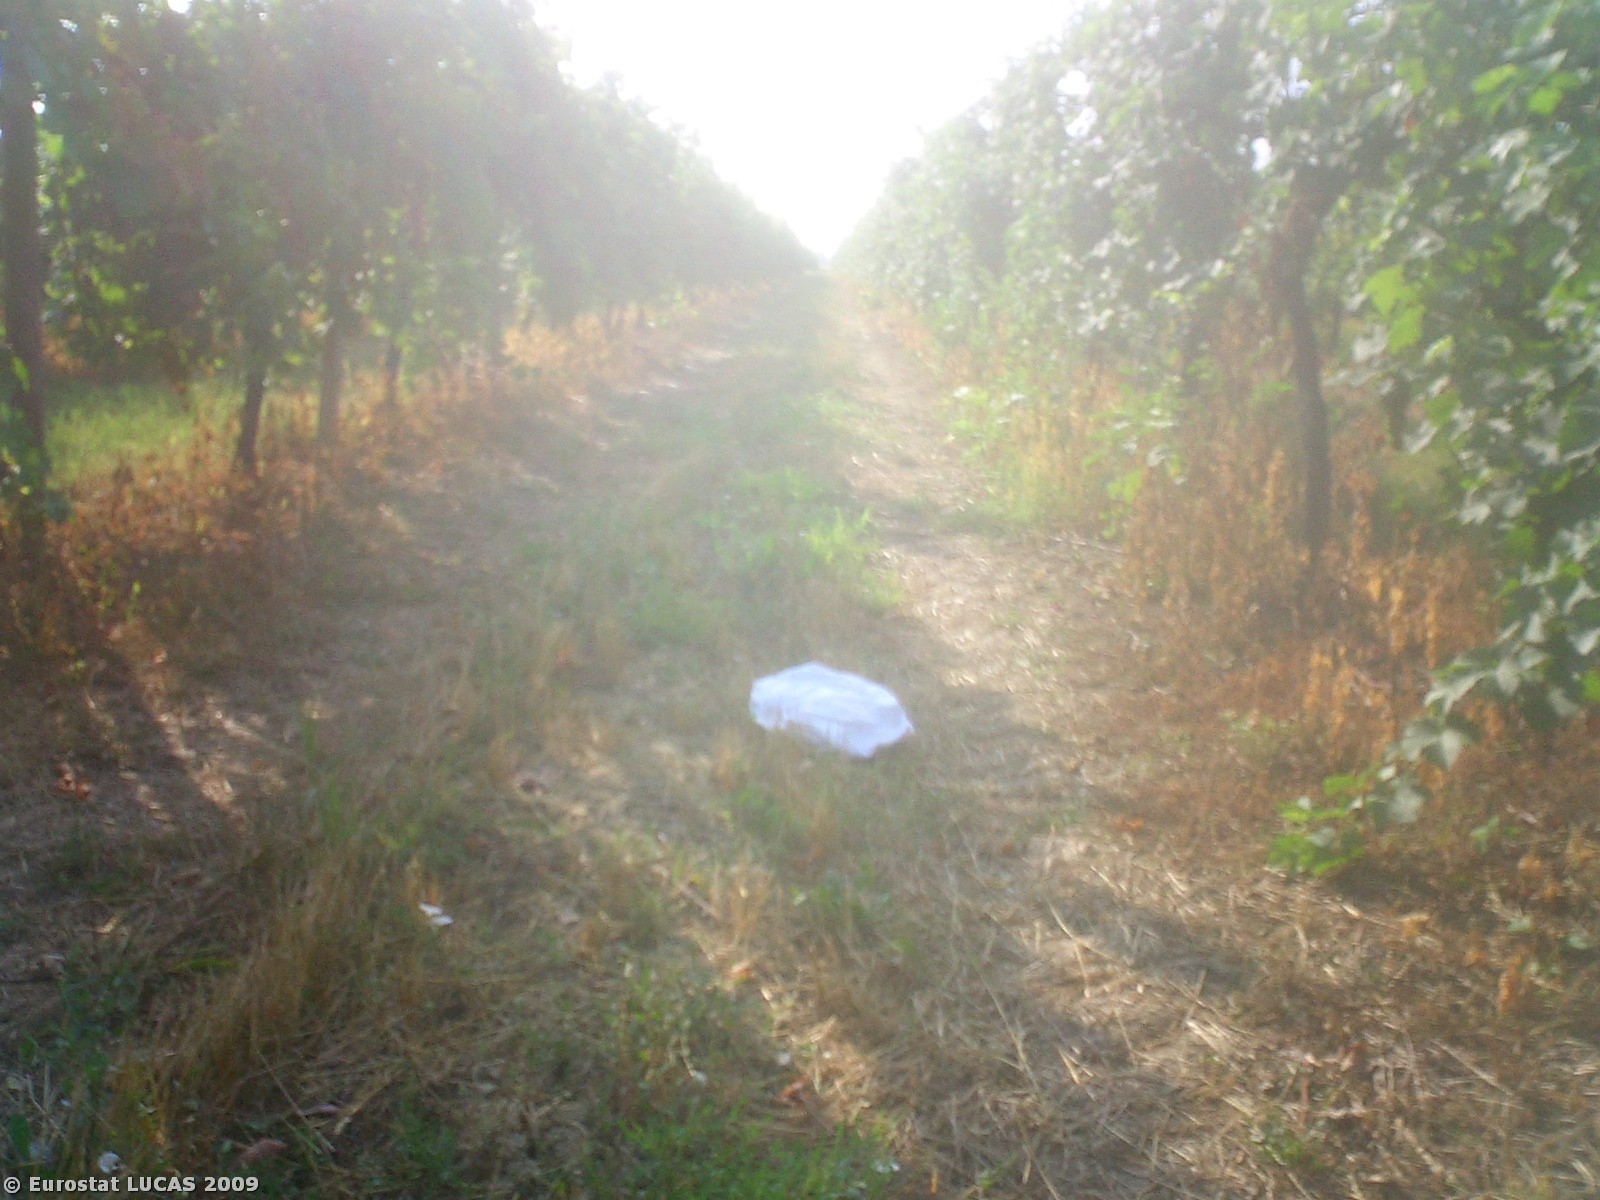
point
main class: Cropland
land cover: Vineyards
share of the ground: 50 - 75 %
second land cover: Grassland with sparse tree/shrub cover
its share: 50 - 75 %
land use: Agriculture (excluding fallow land and kitchen gardens)
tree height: < 5 m
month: July
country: IT
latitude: 44.4942
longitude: 11.9702
